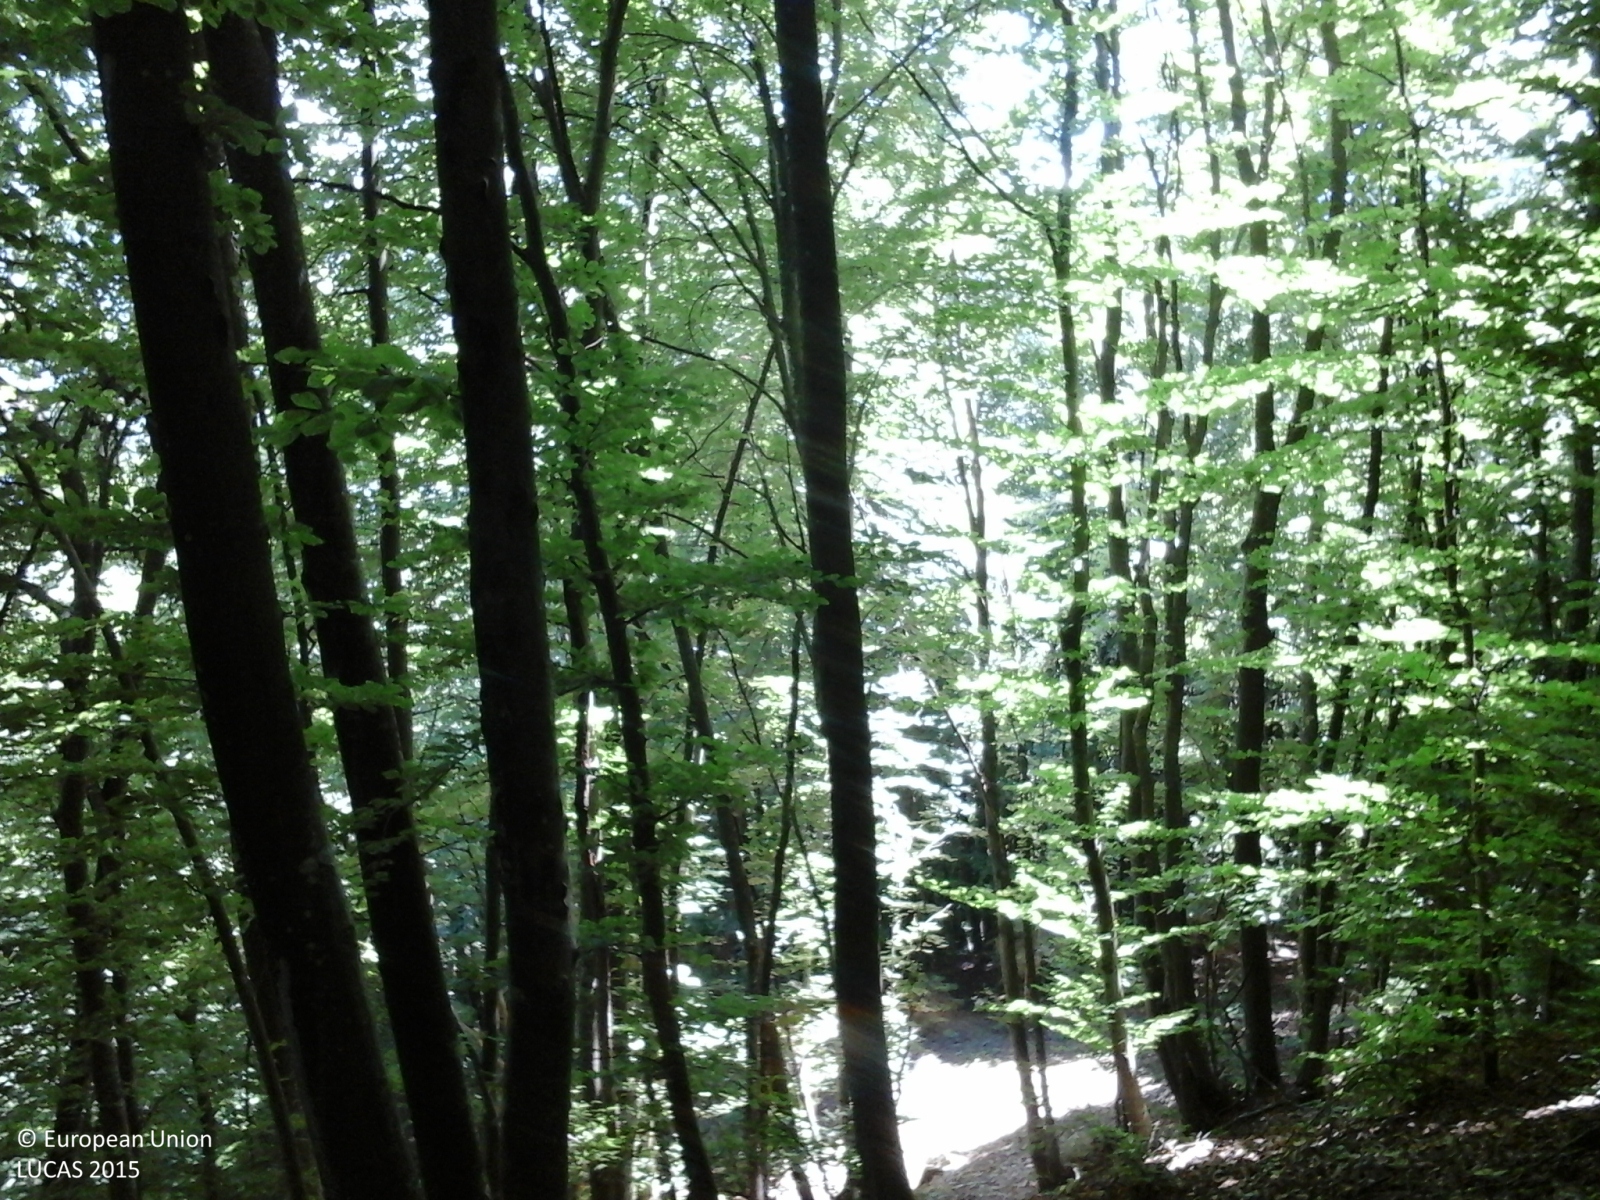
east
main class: Woodland
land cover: Broadleaved woodland
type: mountainous beech forest
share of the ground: > 75 %
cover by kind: broadleaved forest trees 100 %
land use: Semi-natural and natural areas not in use
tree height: > 5 m
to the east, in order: Broadleaved woodland; Grassland without tree/shrub cover; Broadleaved woodland
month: June
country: IT
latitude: 45.9587
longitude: 11.7394
